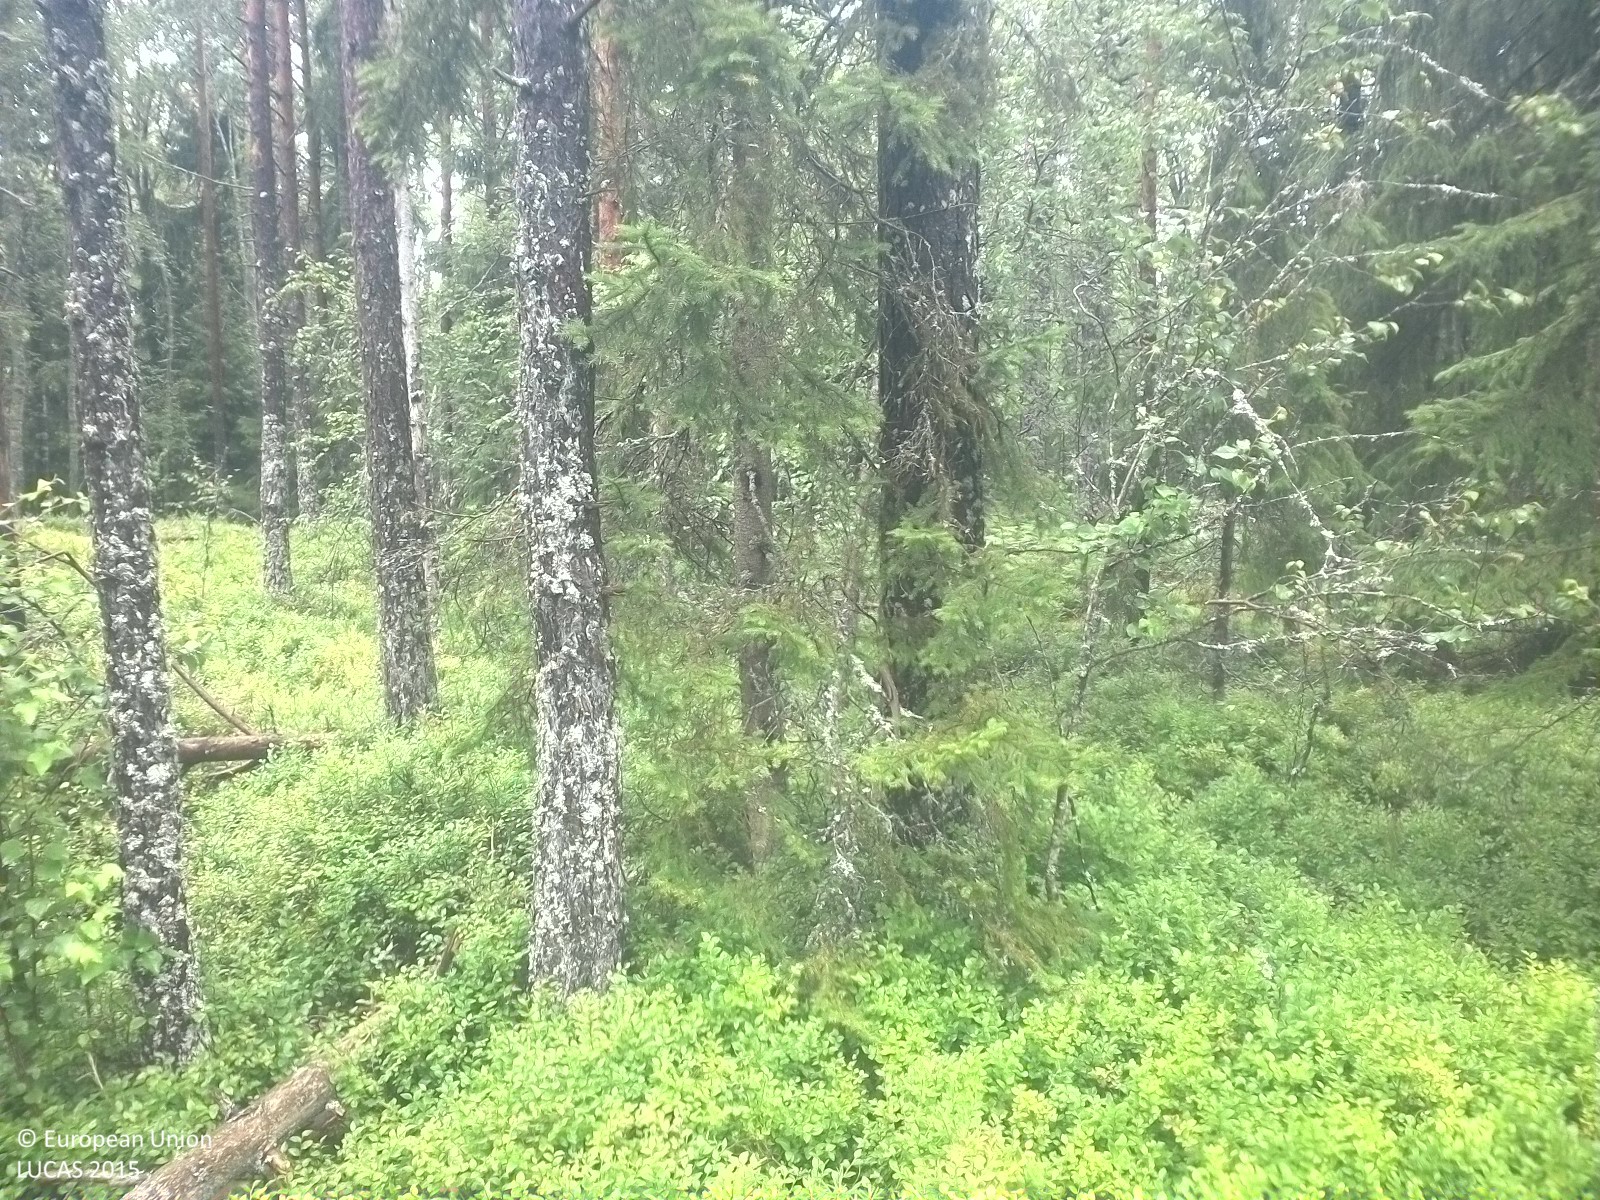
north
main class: Woodland
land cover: Pine dominated mixed woodland
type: boreal forest
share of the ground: 25 - 50 %
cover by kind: herbaceous plants 40 %, coniferous forest trees 25 %, shrubs 15 %, broadleaved forest trees 10 %, lichens and mosses 10 %
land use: Forestry
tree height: > 5 m
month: July
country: SE
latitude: 58.8246
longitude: 15.1367
